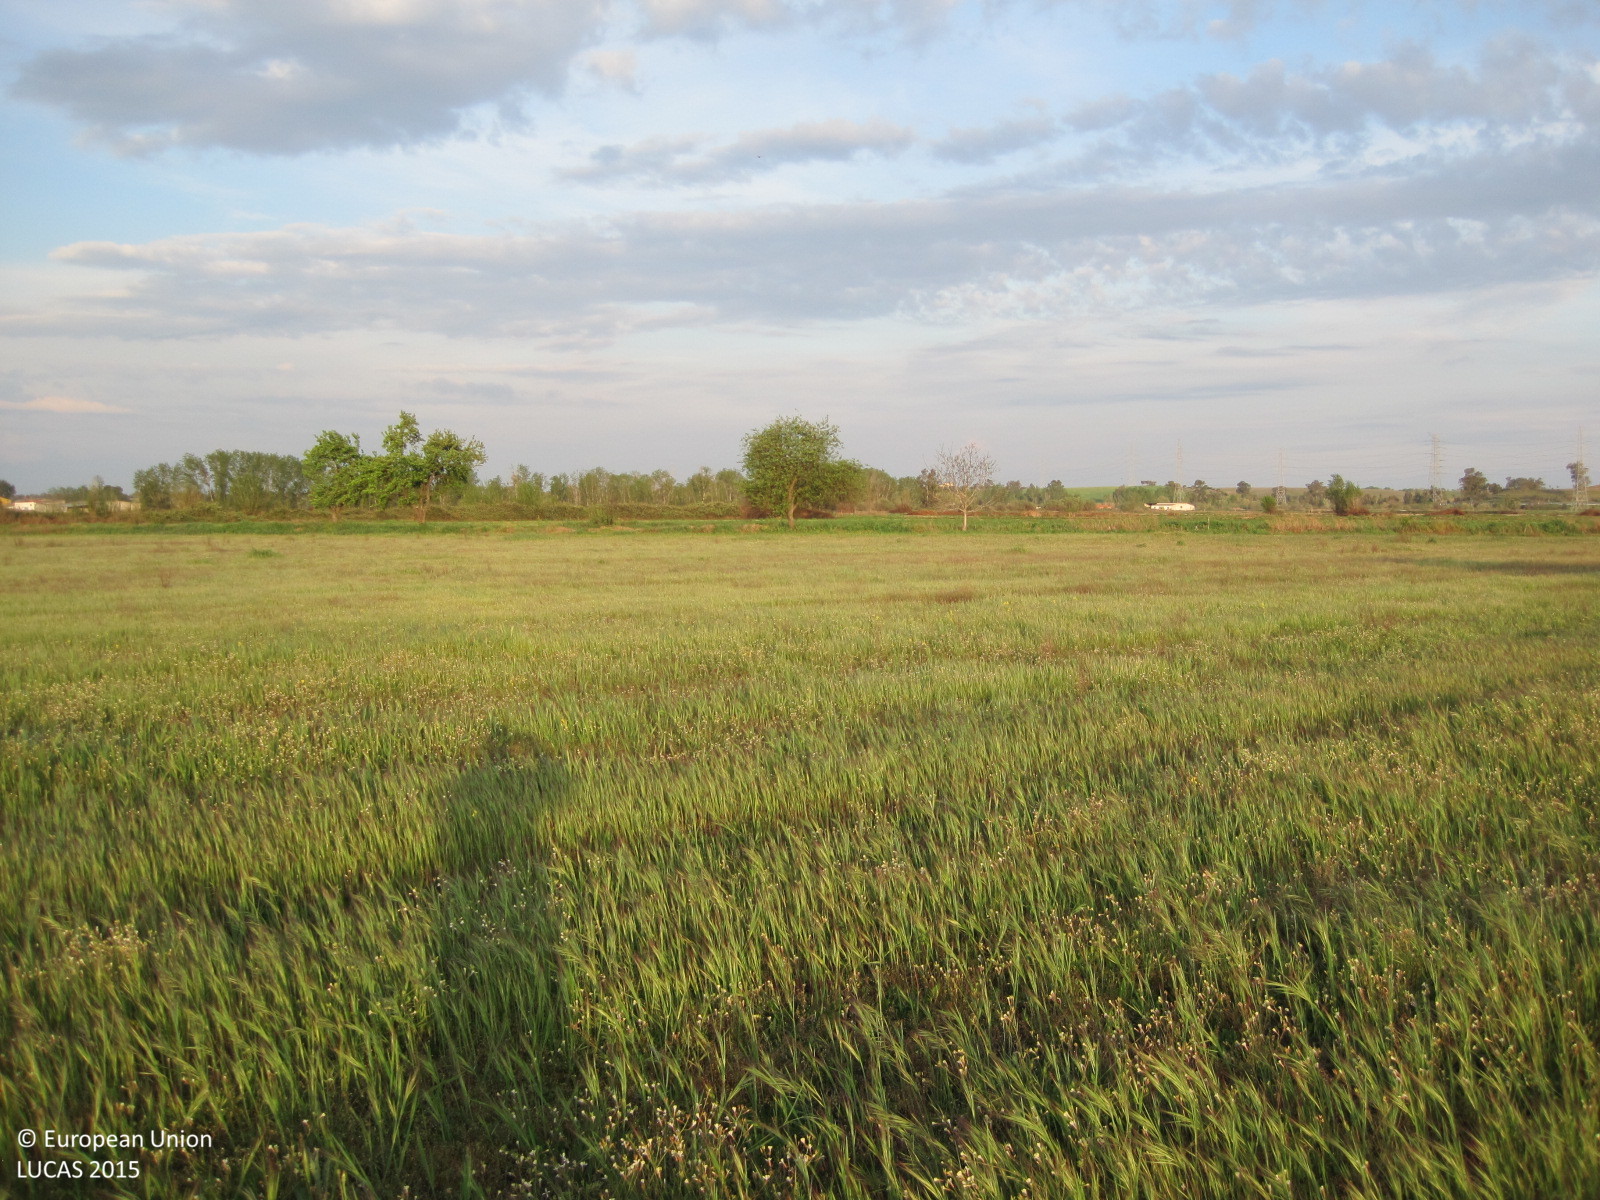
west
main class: Grassland
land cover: Spontaneously vegetated surfaces
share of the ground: > 75 %
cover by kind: herbaceous plants 100 %
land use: Fallow land
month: April
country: ES
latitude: 39.9272
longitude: -4.9205
